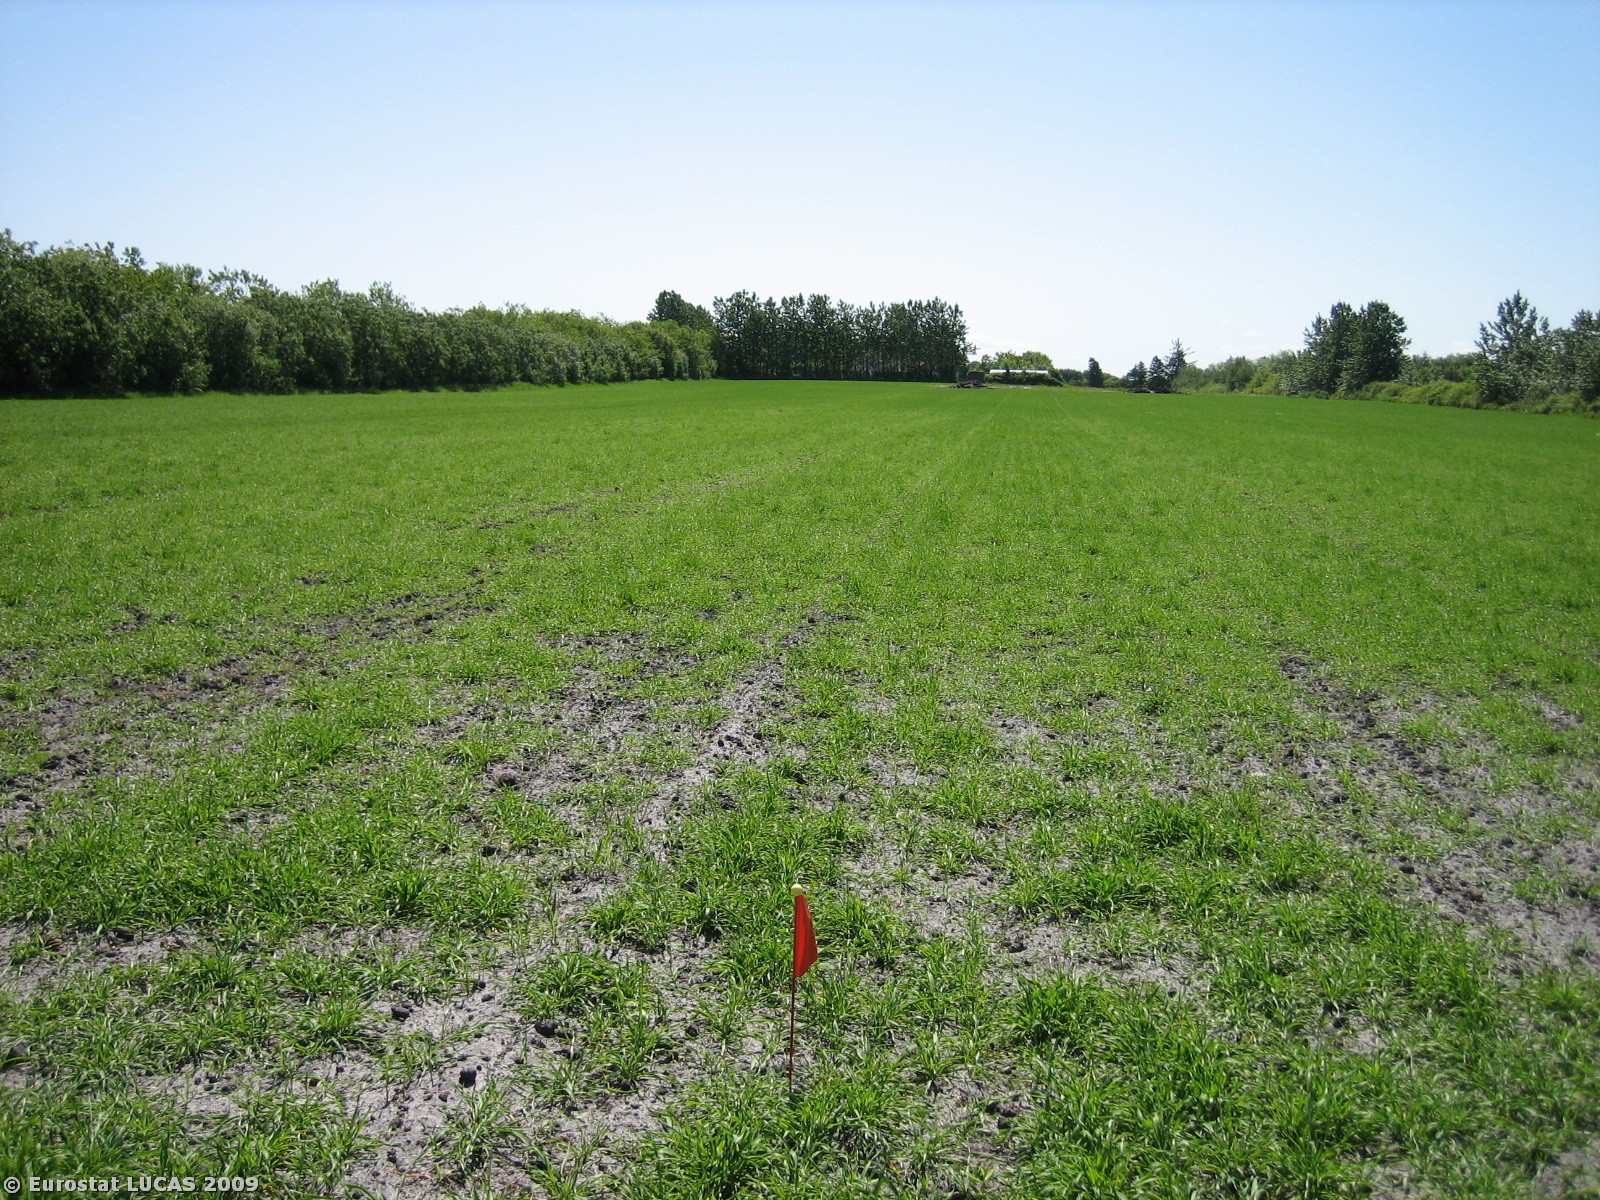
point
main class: Cropland
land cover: Barley
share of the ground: 50 - 75 %
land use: Agriculture (excluding fallow land and kitchen gardens)
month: May
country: DK
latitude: 55.8951
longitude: 8.8658
